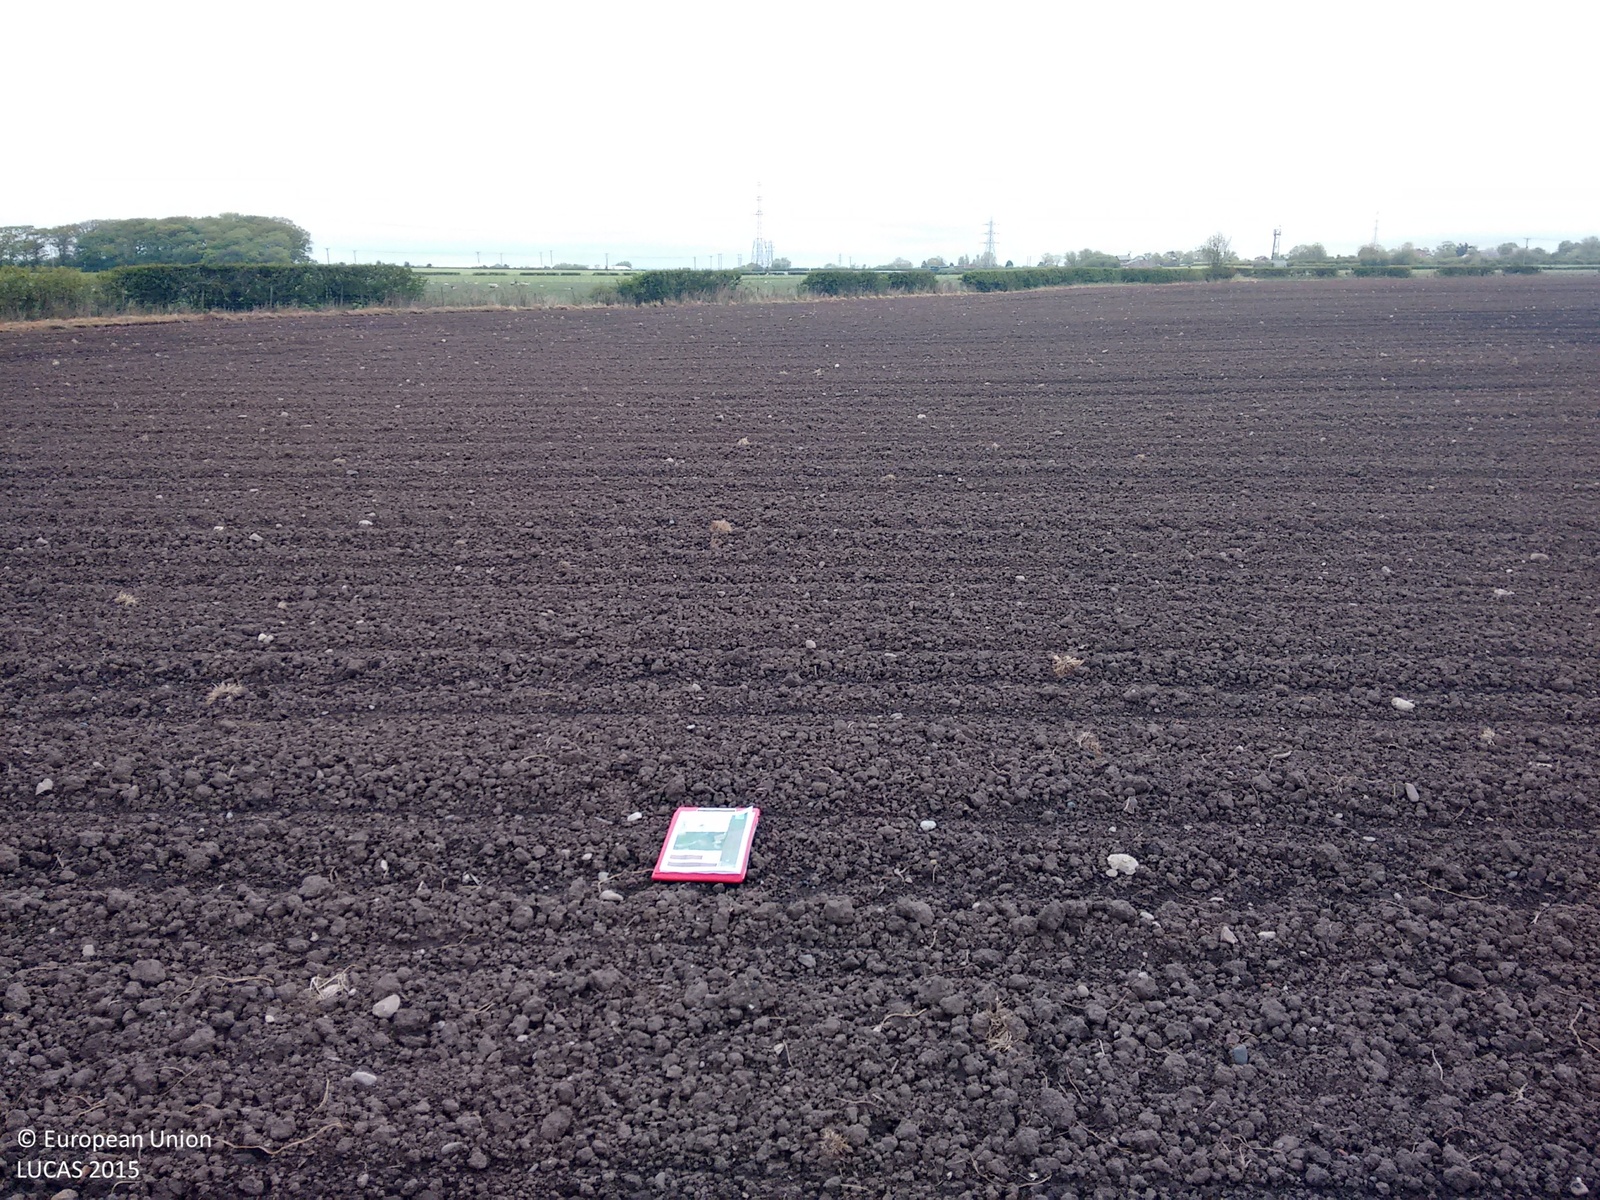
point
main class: Cropland
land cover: Maize
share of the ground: < 10 %
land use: Agriculture (excluding fallow land and kitchen gardens)
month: May
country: GB
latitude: 53.7660
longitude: -2.8910
